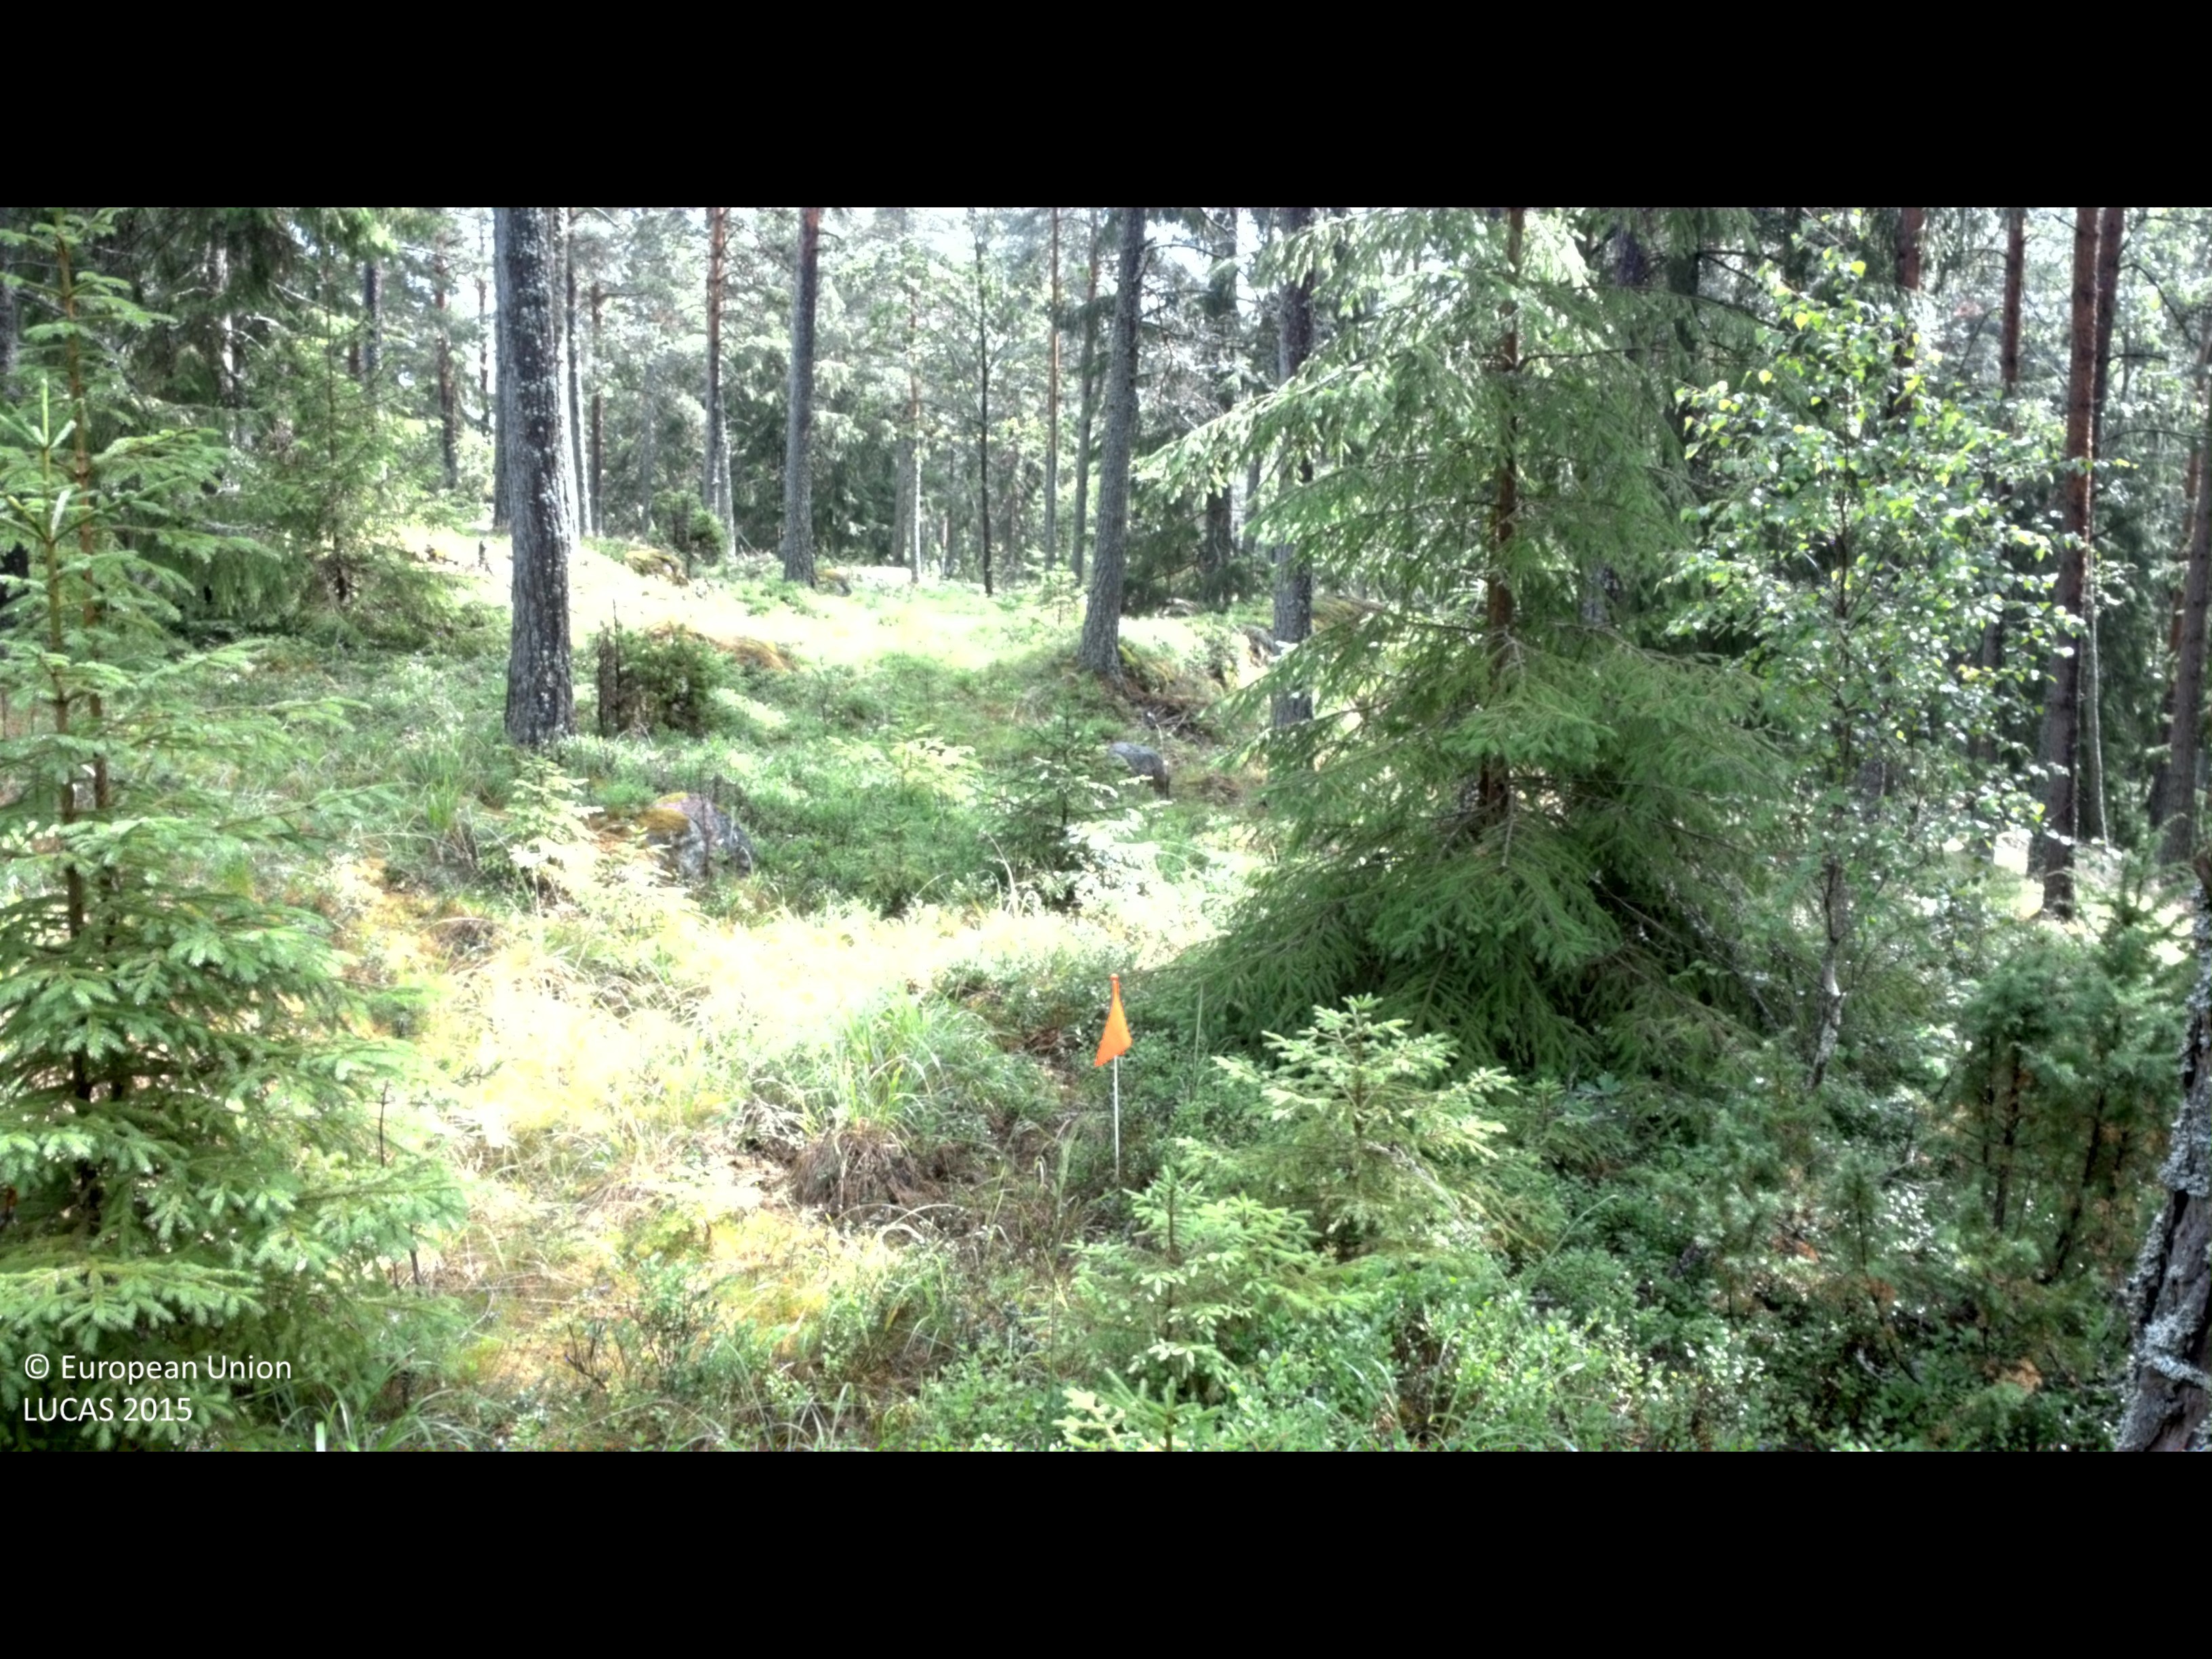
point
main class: Woodland
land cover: Pine dominated coniferous woodland
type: boreal forest
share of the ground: 50 - 75 %
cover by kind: coniferous forest trees 55 %, shrubs 30 %, lichens and mosses 10 %, herbaceous plants 5 %
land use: Forestry
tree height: > 5 m
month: July
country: SE
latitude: 58.3652
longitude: 16.2008
